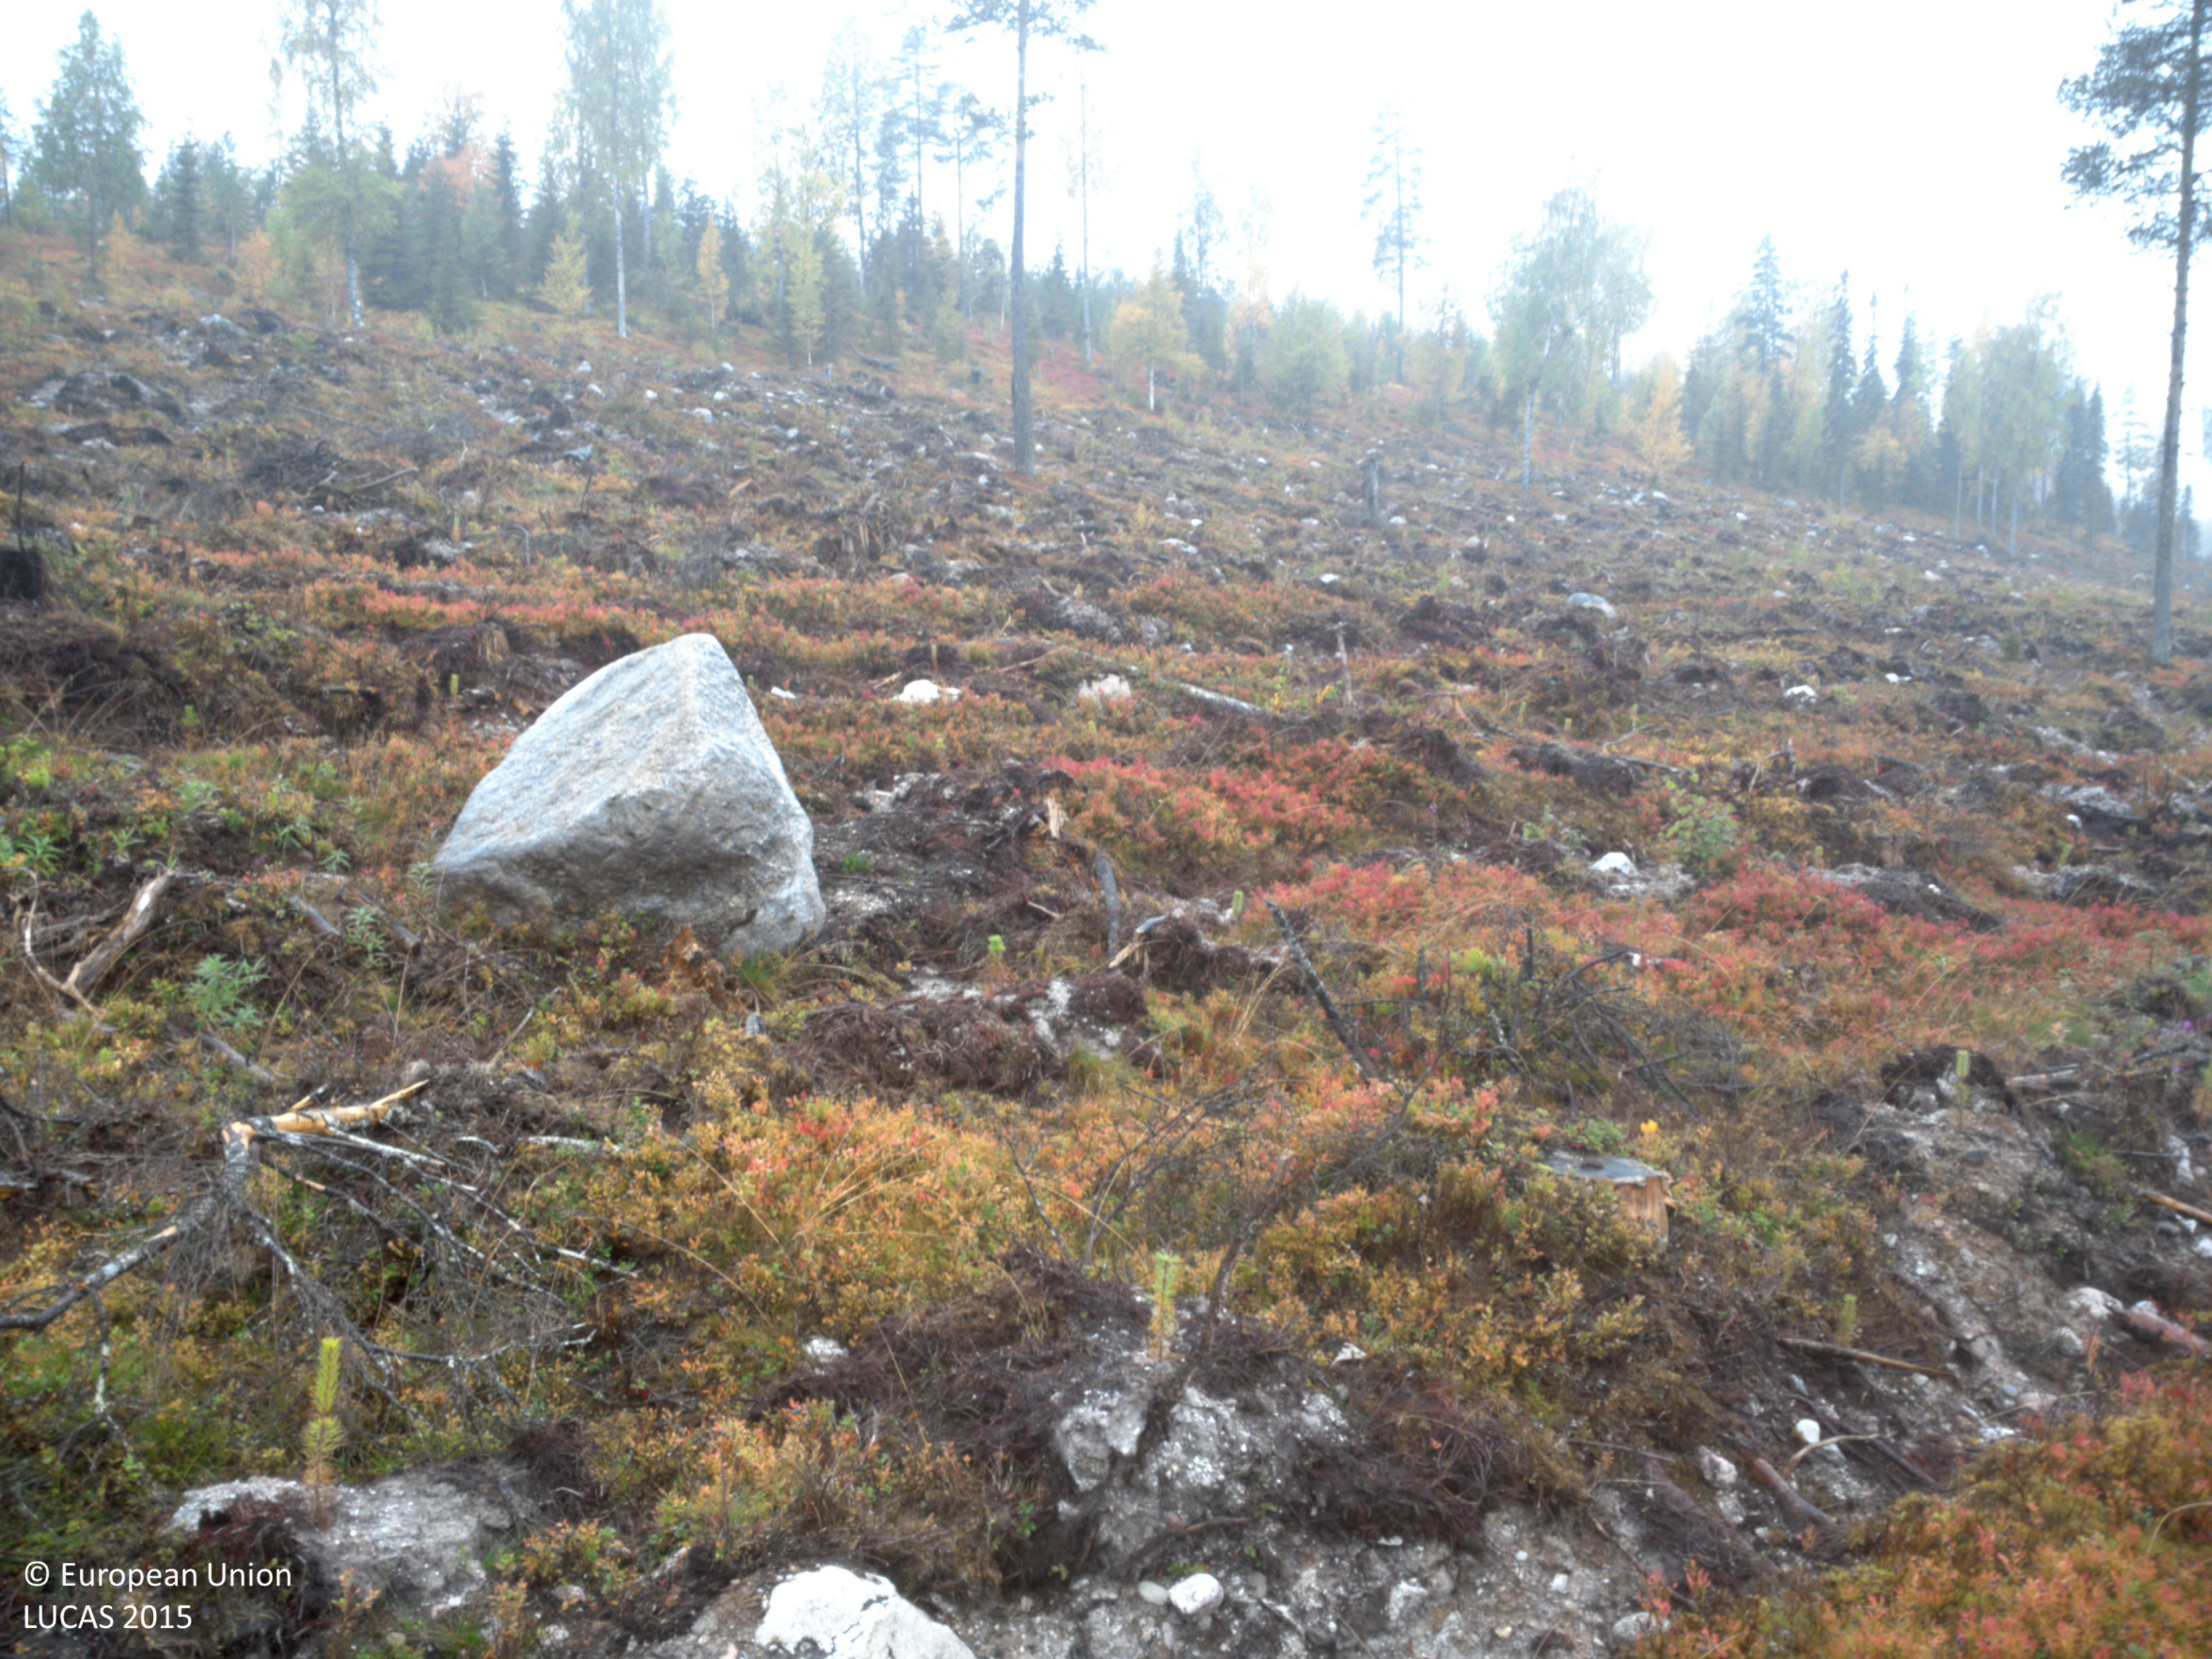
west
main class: Shrubland
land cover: Shrubland with sparse tree cover
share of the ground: 50 - 75 %
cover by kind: shrubs 65 %, unconsolidated bare surface 25 %, coniferous forest trees 5 %, consolidated bare surface 5 %
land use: Forestry
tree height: < 5 m
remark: Clear cut
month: September
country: SE
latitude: 64.8932
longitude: 19.2398
